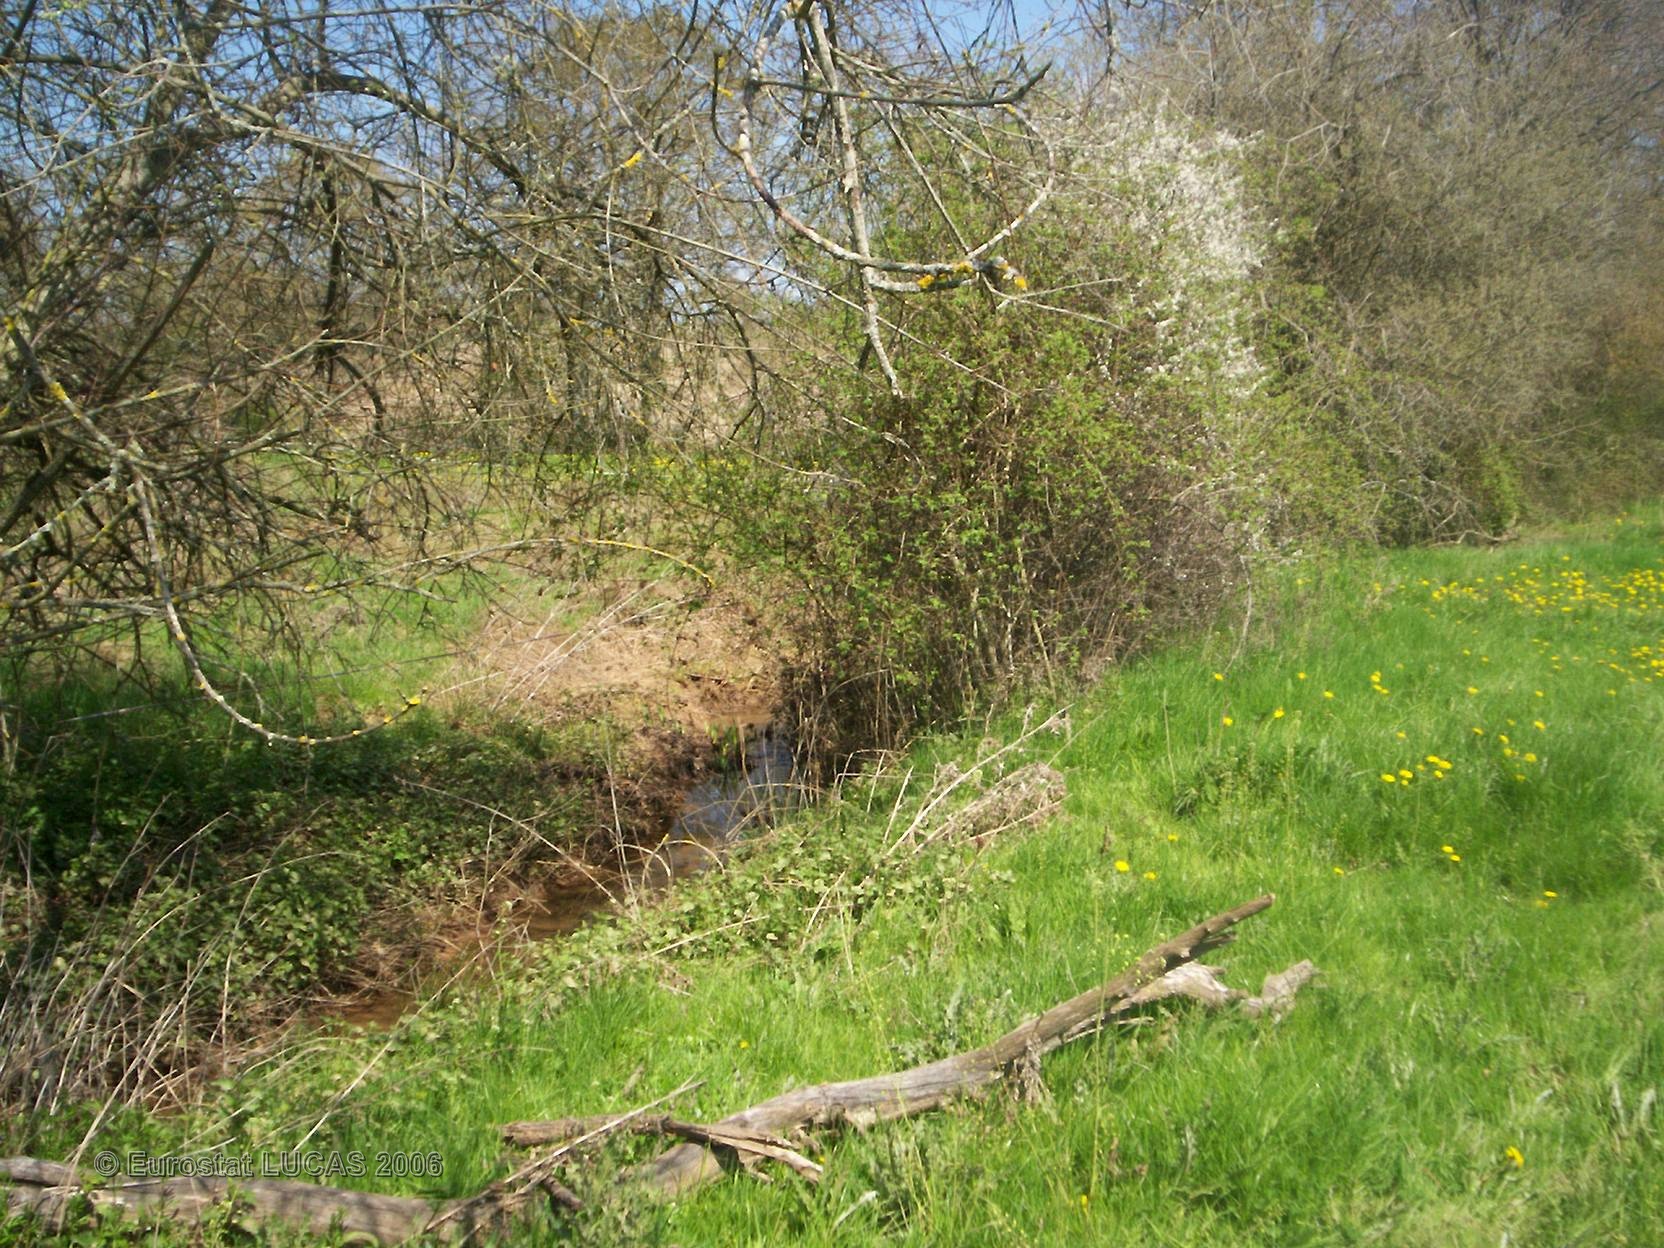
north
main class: Grassland
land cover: Grassland without tree/shrub cover
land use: Agriculture (excluding fallow land and kitchen gardens)
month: April
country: FR
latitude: 46.6335
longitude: 3.0871
